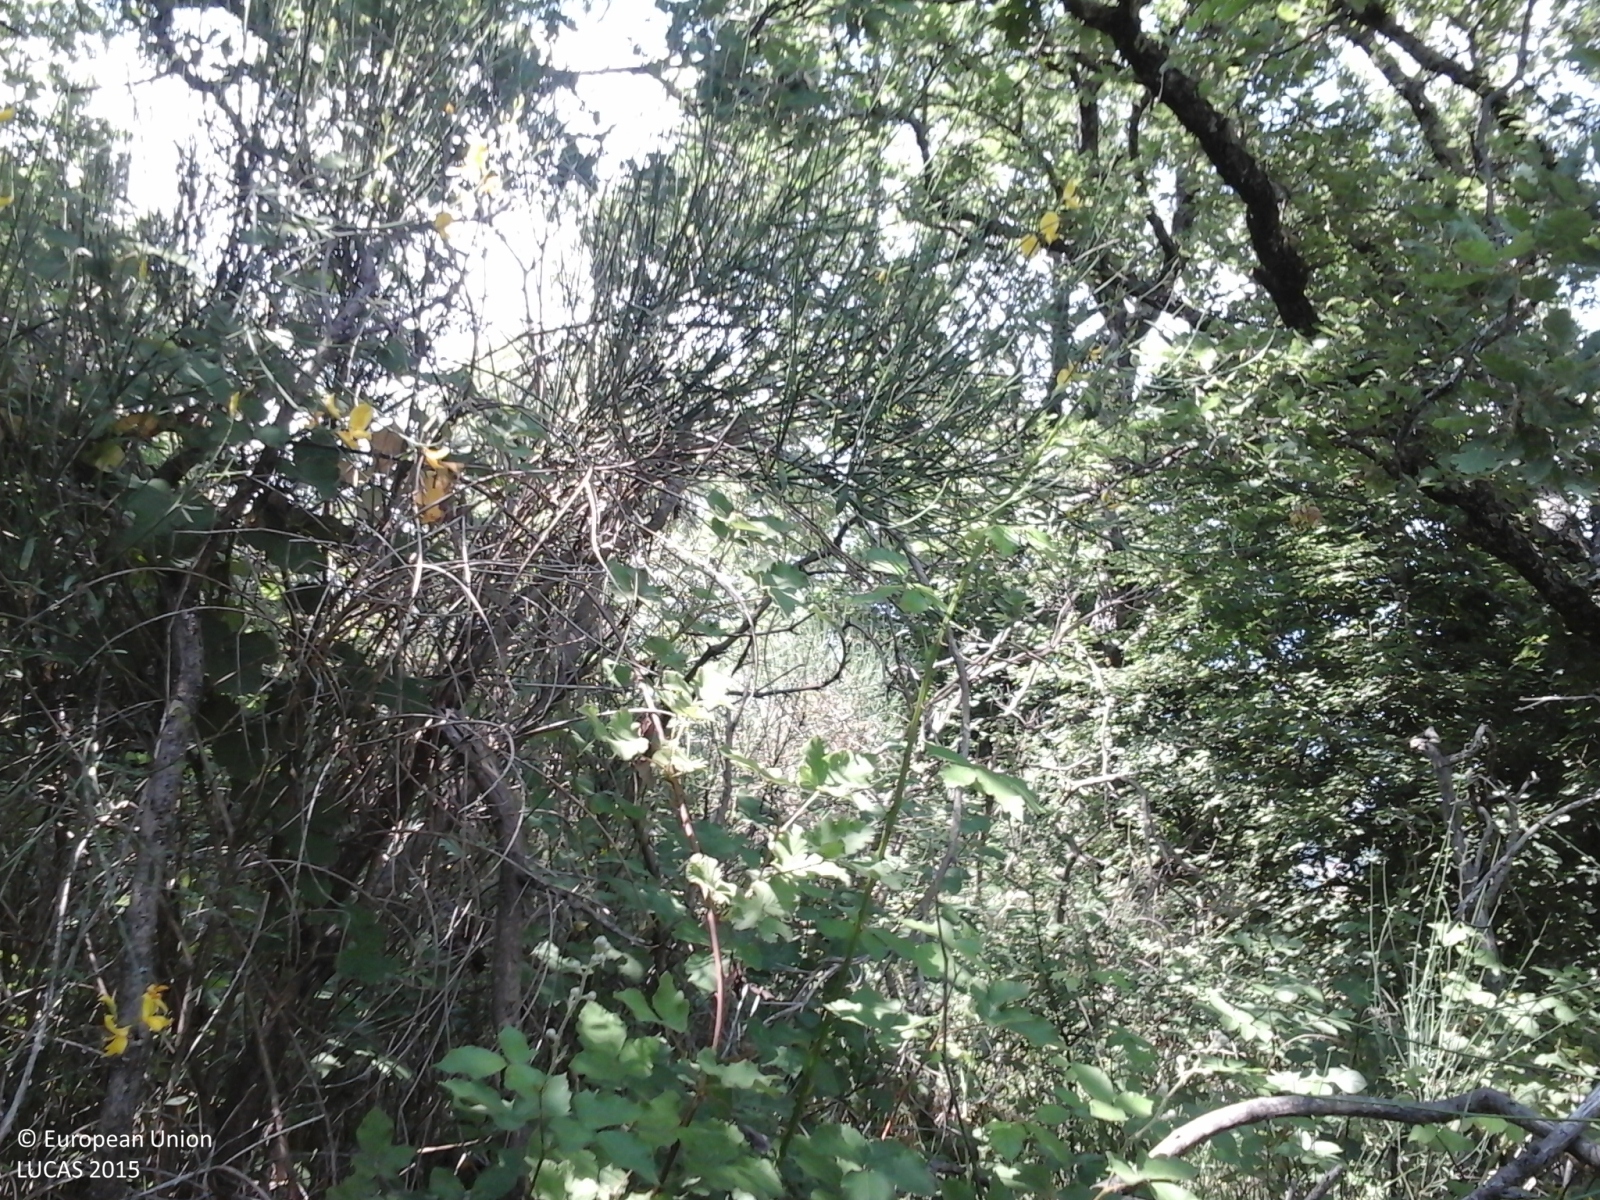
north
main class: Shrubland
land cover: Shrubland with sparse tree cover
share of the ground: > 75 %
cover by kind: shrubs 90 %, broadleaved forest trees 5 %, herbaceous plants 5 %
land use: Semi-natural and natural areas not in use
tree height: < 5 m
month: June
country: IT
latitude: 41.6281
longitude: 13.6953
